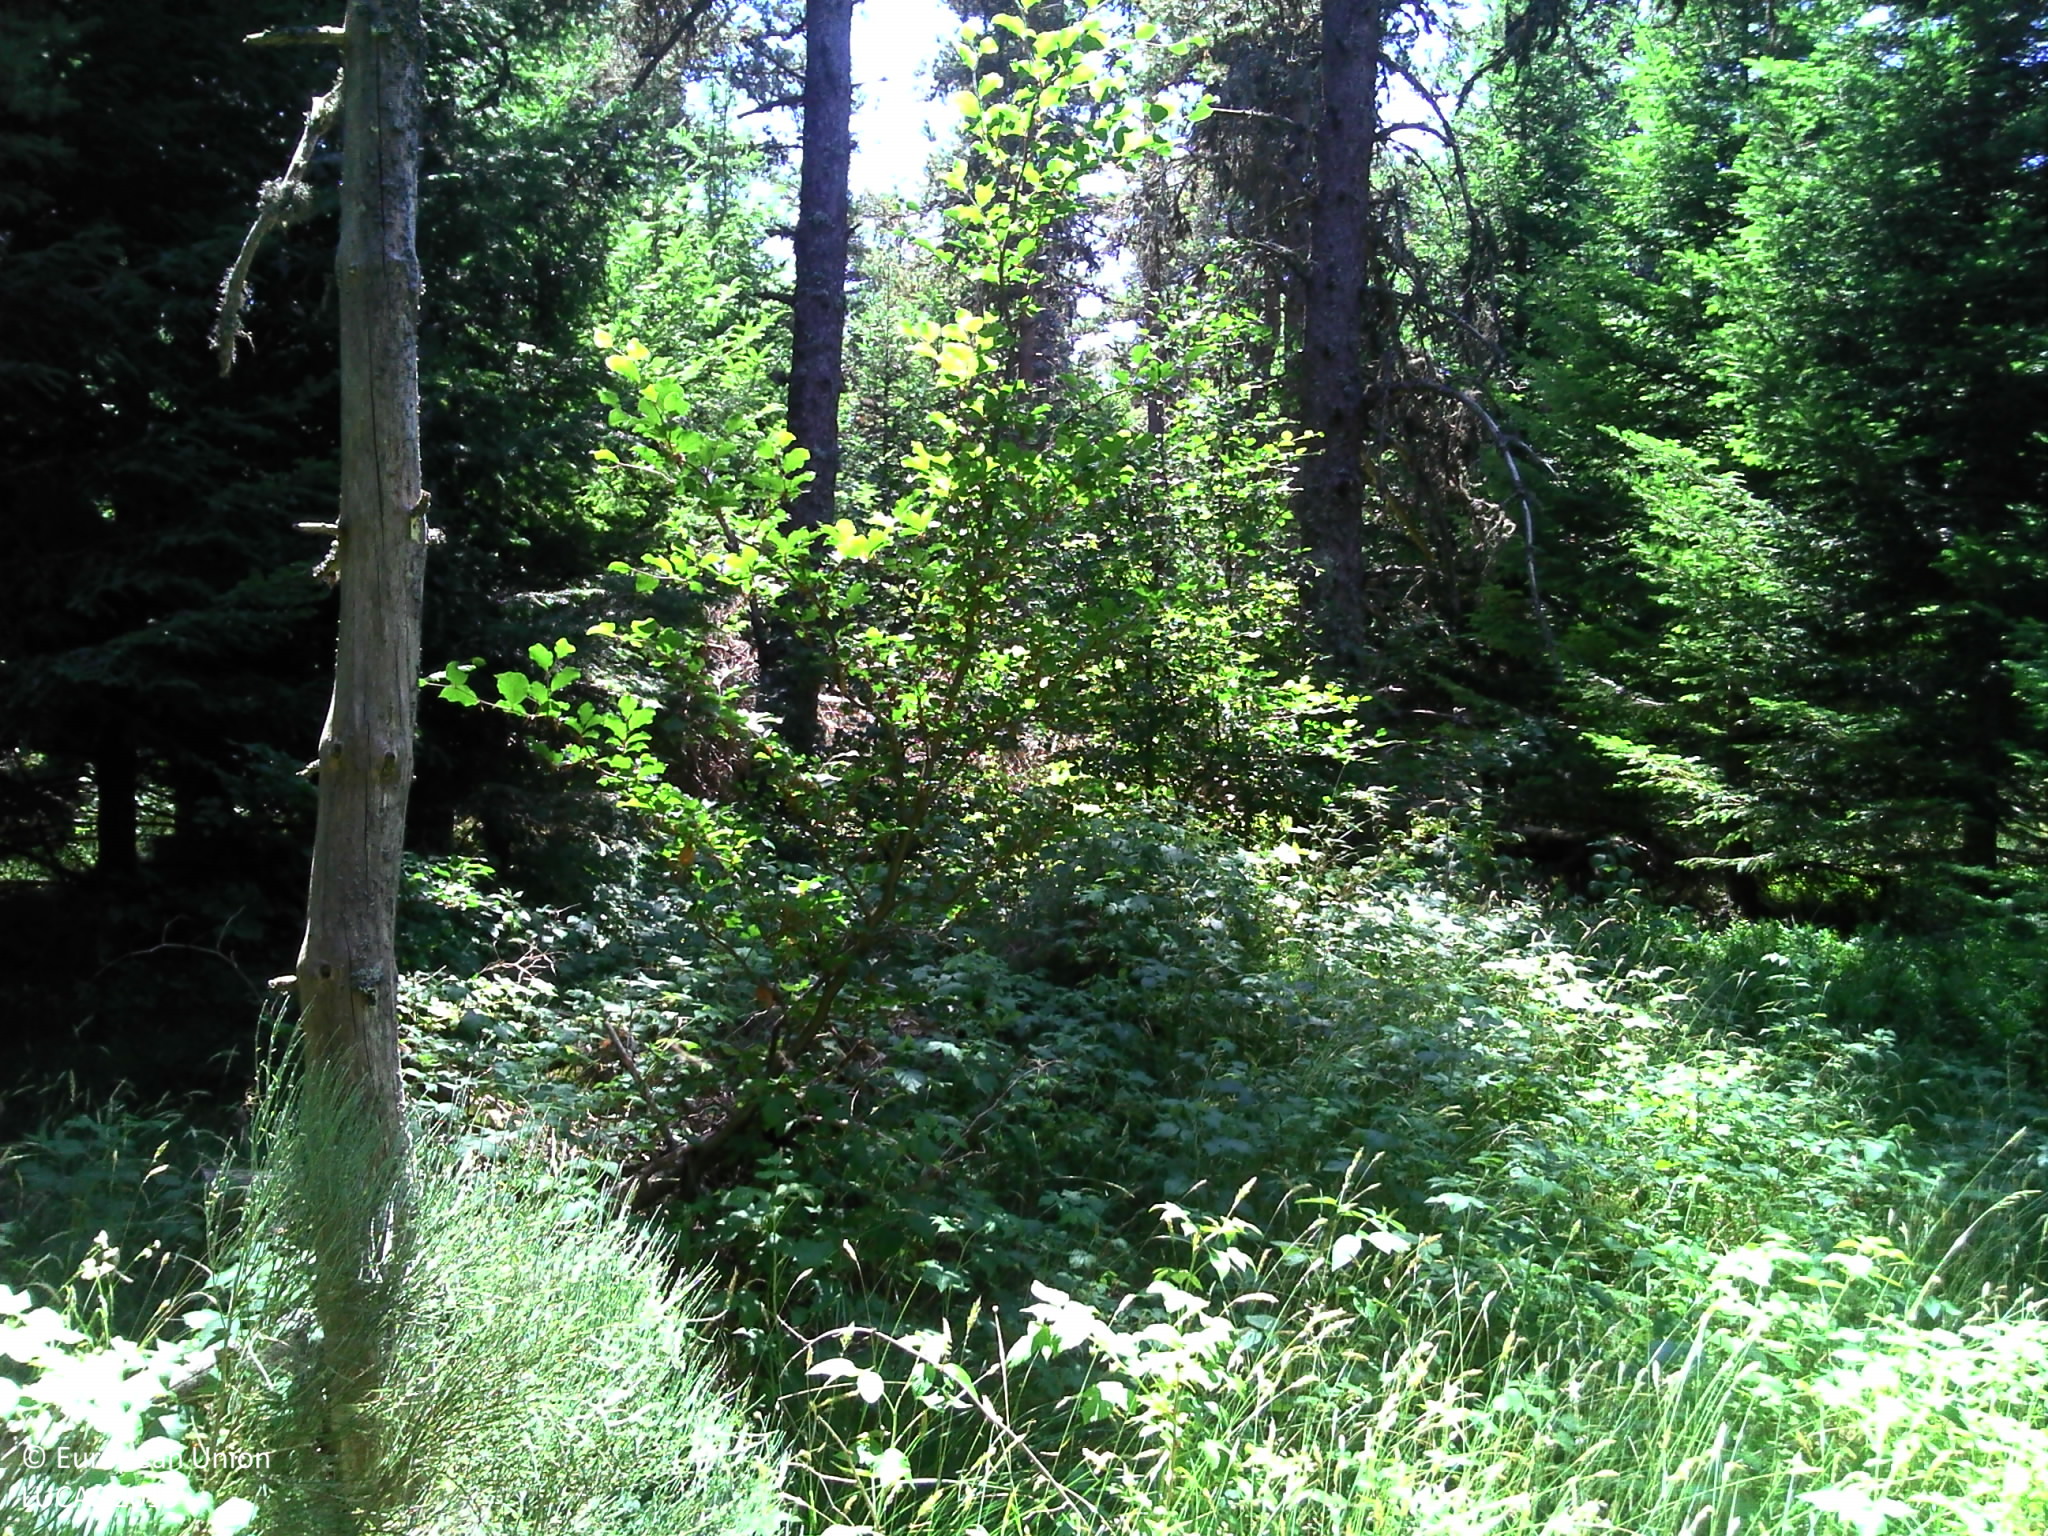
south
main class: Woodland
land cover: Spruce dominated coniferous woodland
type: exotic forest
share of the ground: > 75 %
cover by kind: coniferous forest trees 80 %, shrubs 10 %, herbaceous plants 10 %
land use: Forestry
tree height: > 5 m
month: July
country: FR
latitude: 44.9020
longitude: 3.4309
